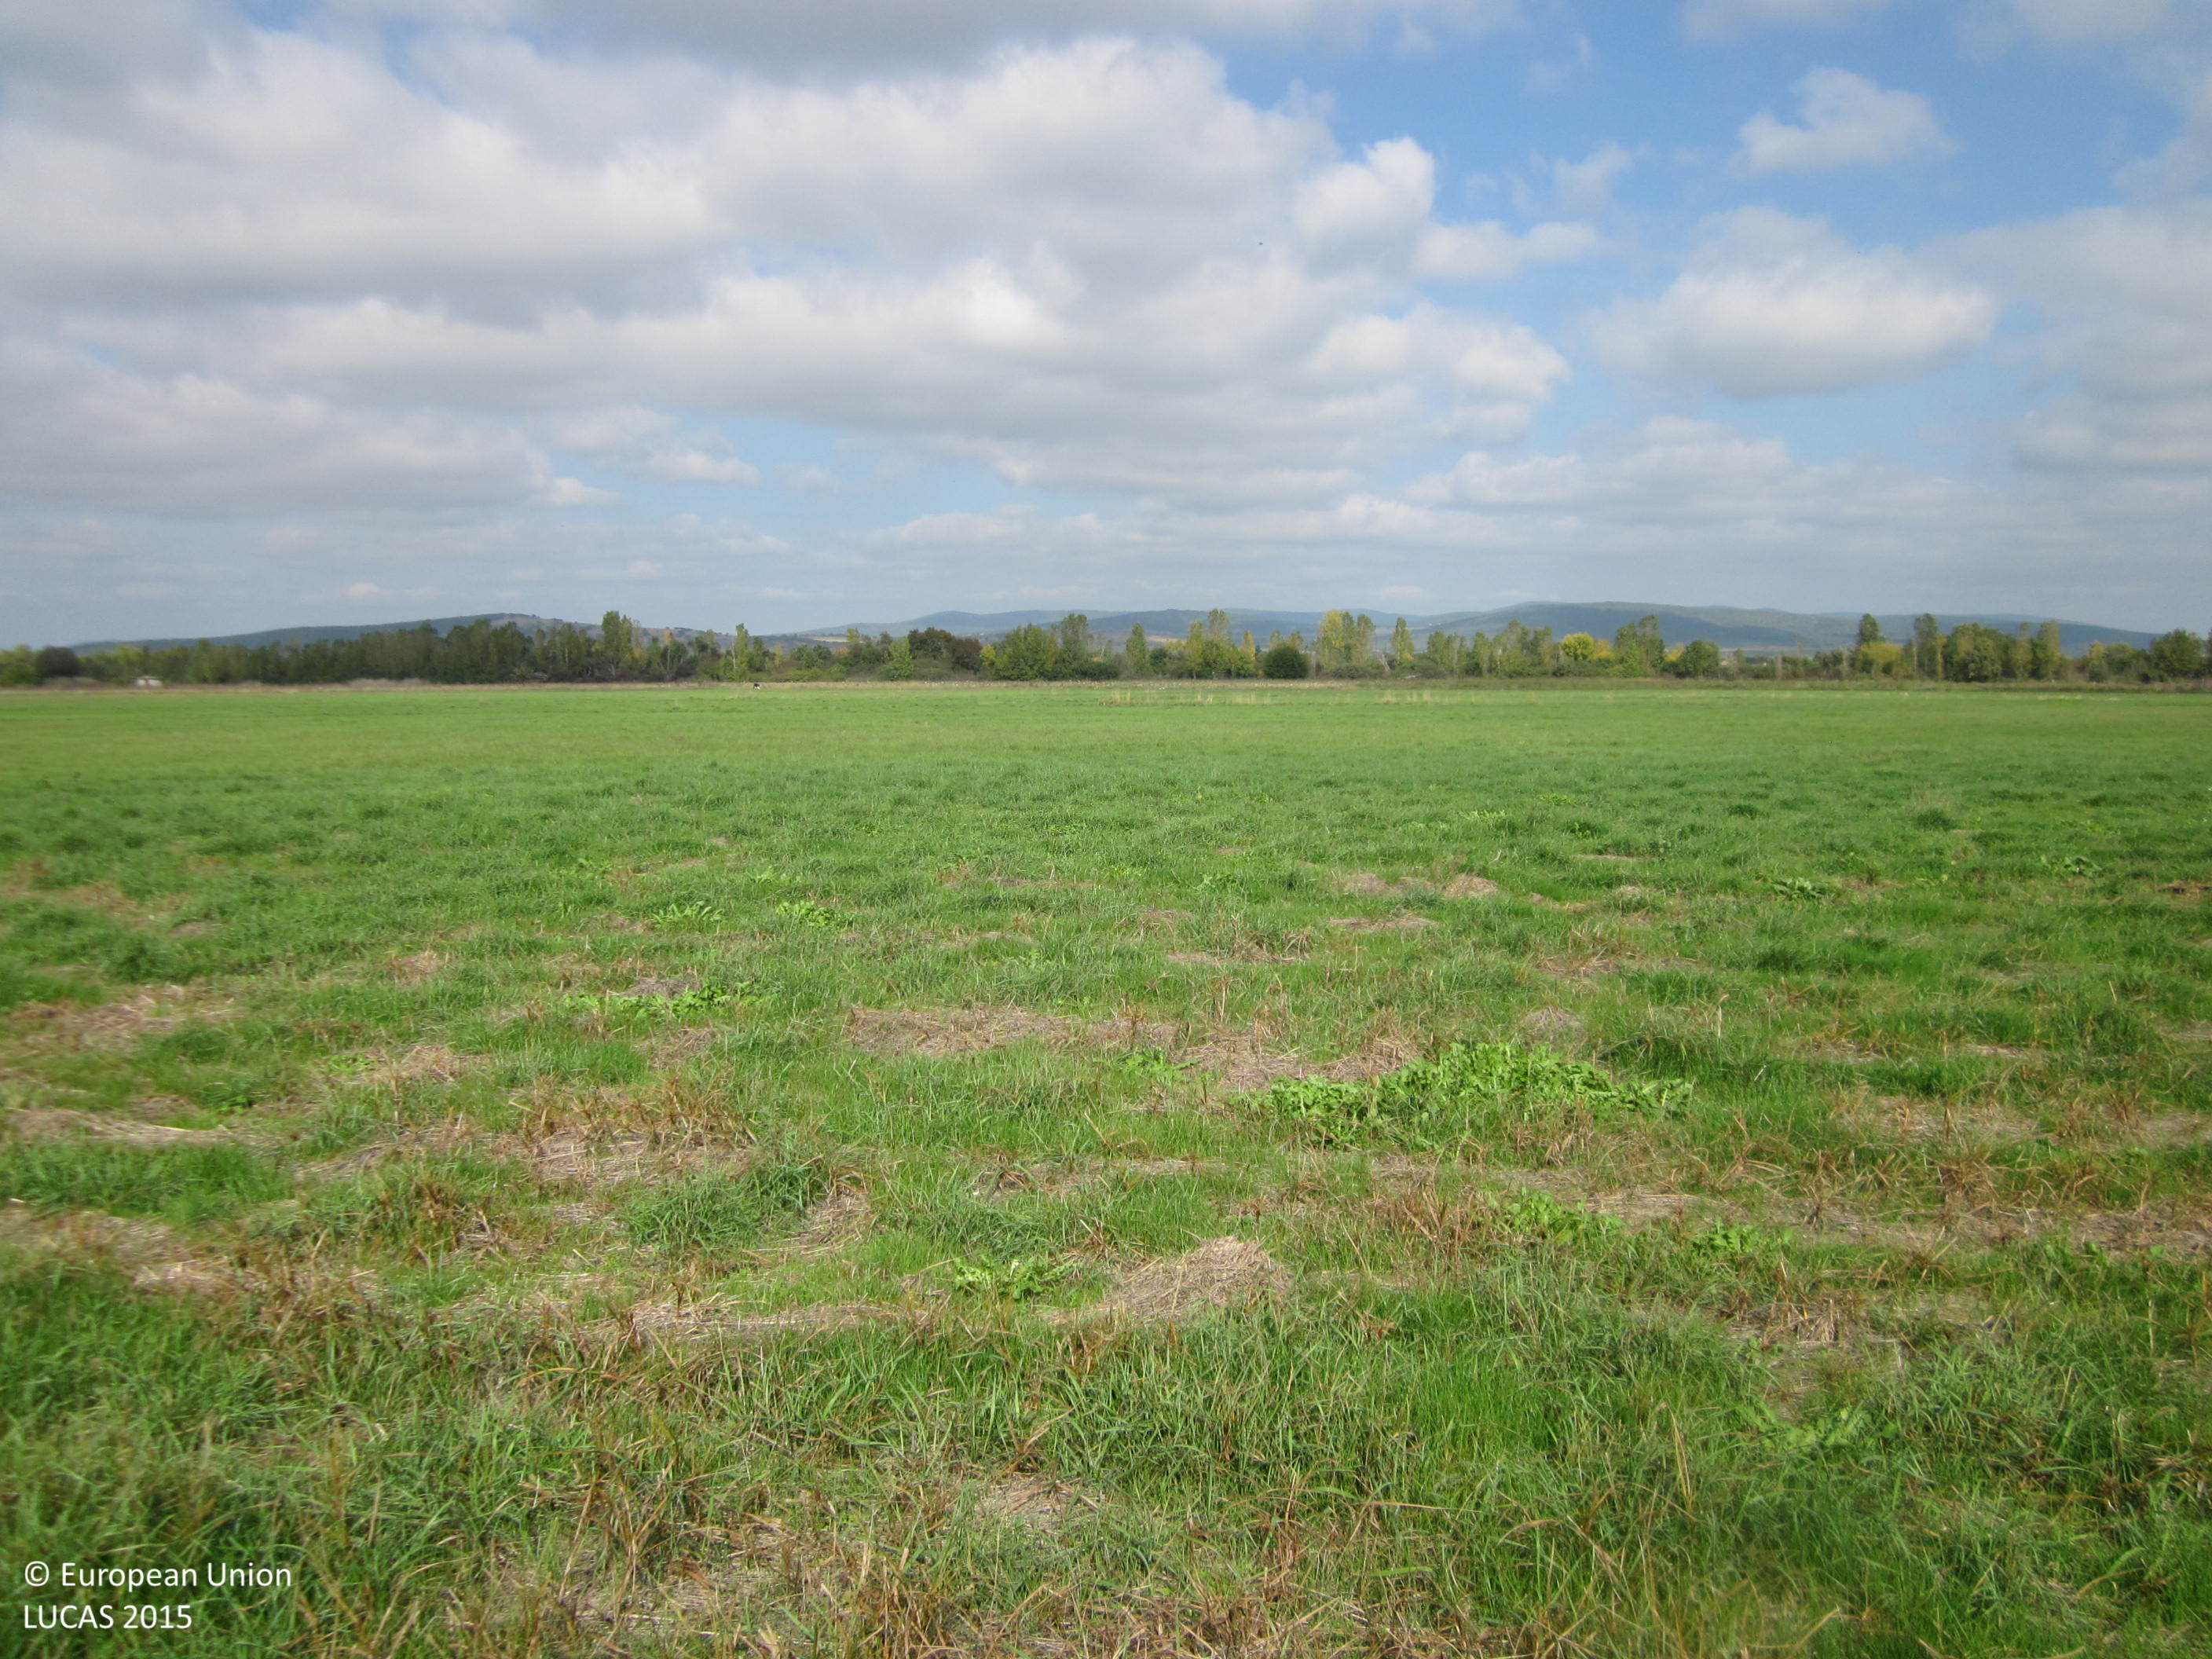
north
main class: Grassland
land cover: Grassland without tree/shrub cover
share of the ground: > 75 %
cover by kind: herbaceous plants 100 %
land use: Agriculture (excluding fallow land and kitchen gardens)
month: October
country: BG
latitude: 42.6964
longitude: 26.8888
